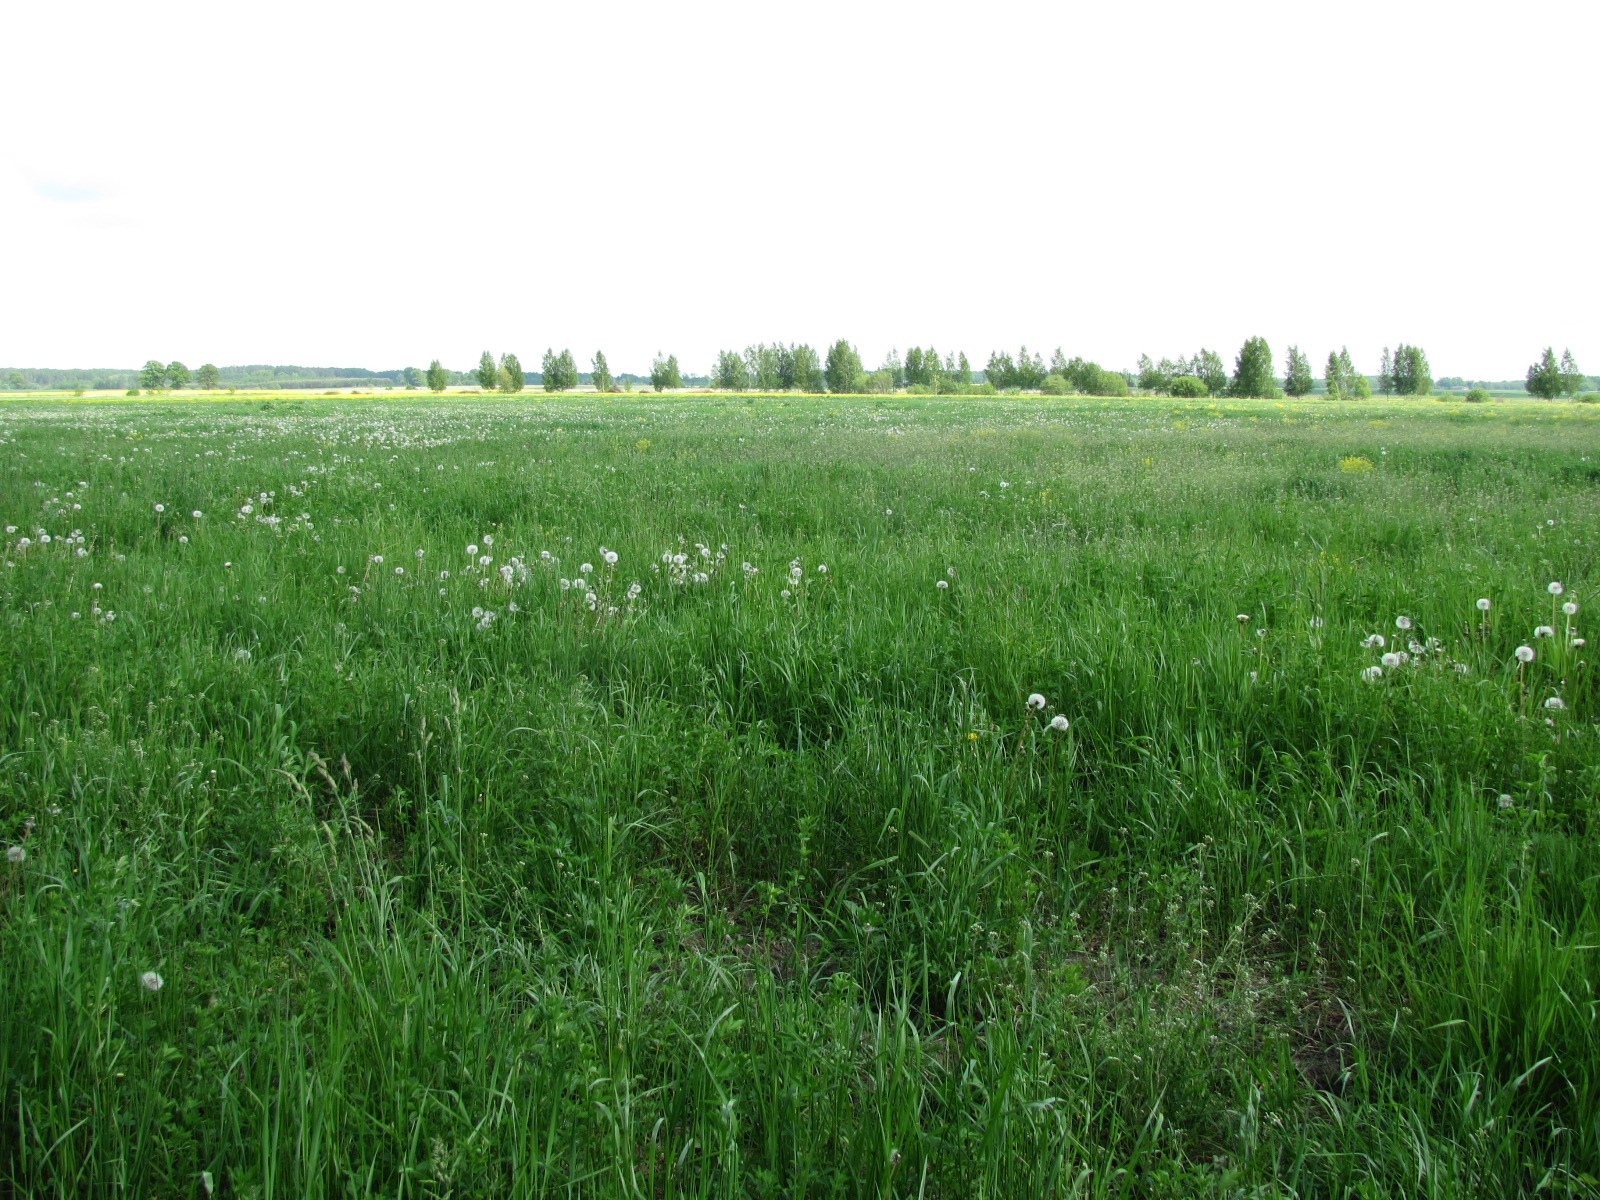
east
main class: Woodland
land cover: Broadleaved woodland
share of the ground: > 75 %
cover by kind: broadleaved forest trees 100 %
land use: Agriculture (excluding fallow land and kitchen gardens)
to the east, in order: Grassland without tree/shrub cover
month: May
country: LV
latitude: 56.5459
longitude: 24.0246
